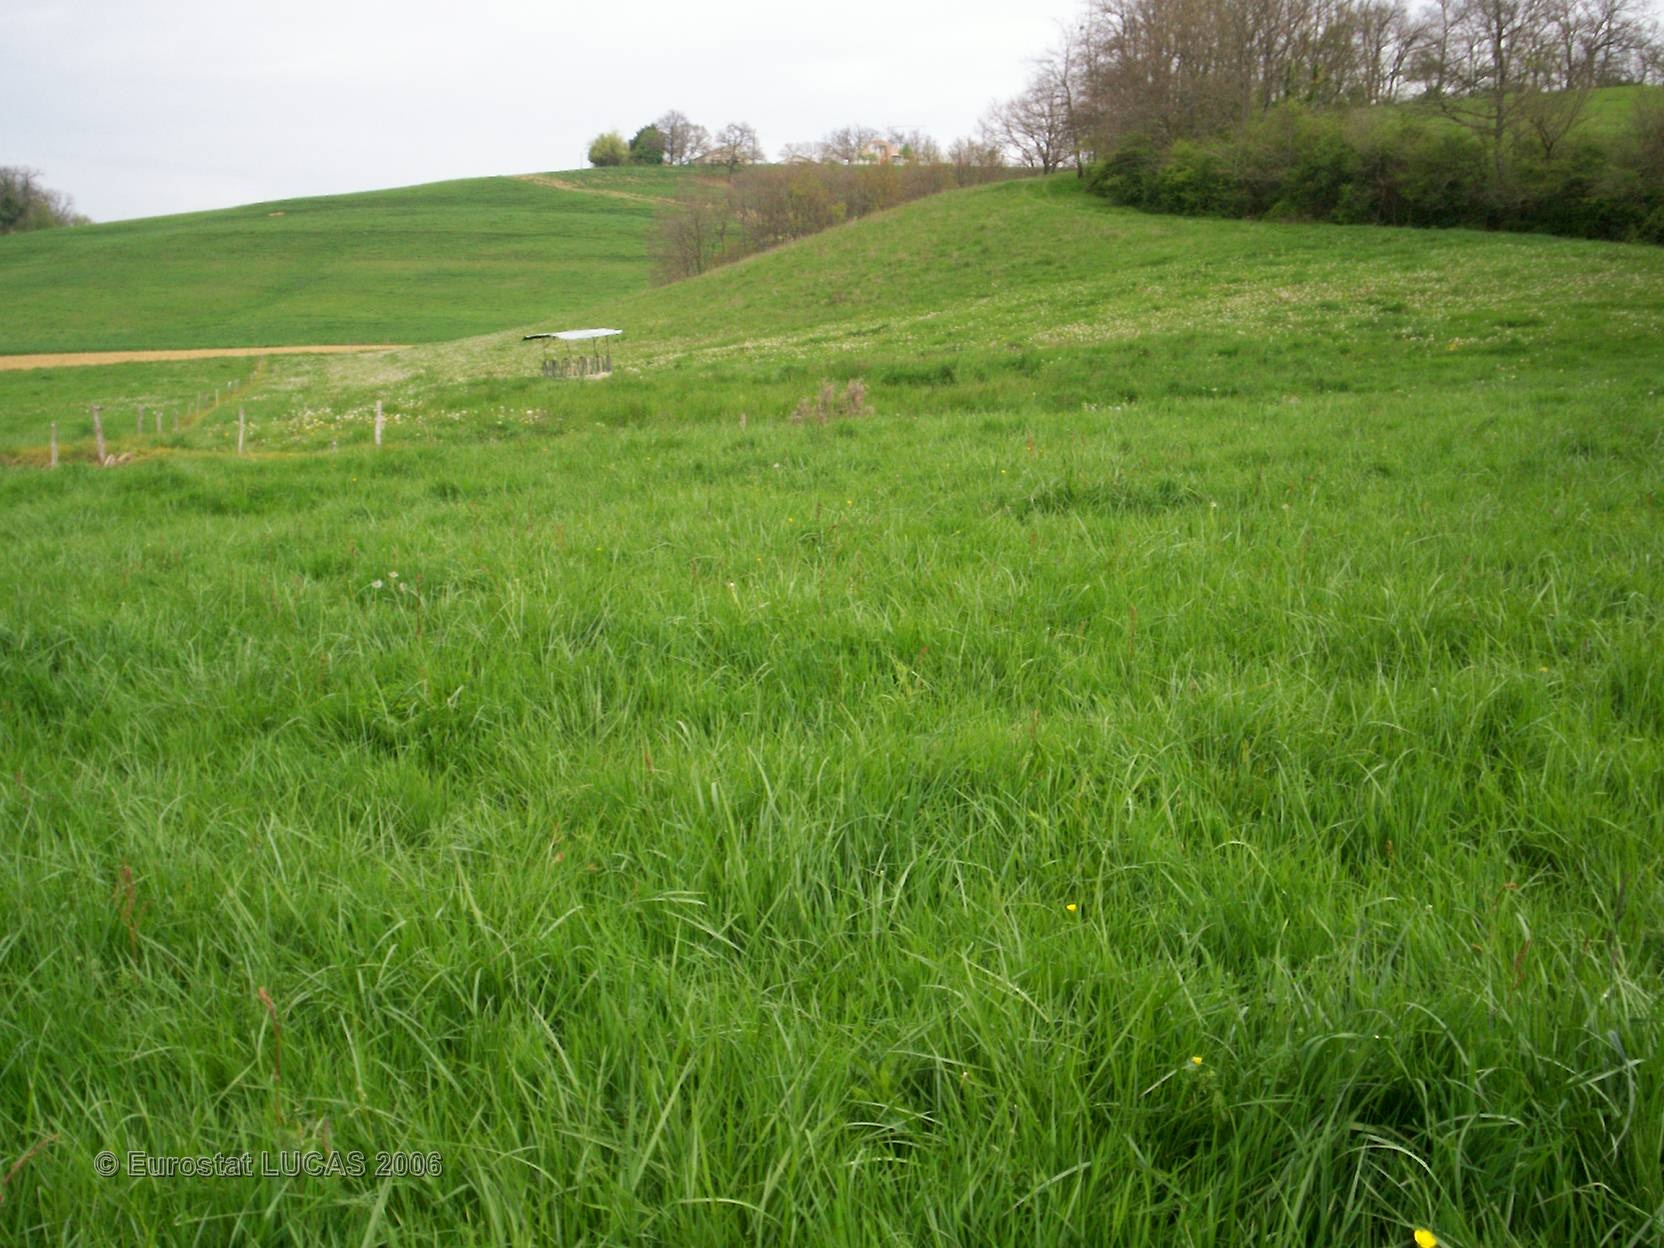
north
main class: Grassland
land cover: Grassland without tree/shrub cover
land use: Agriculture (excluding fallow land and kitchen gardens)
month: April
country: FR
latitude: 43.7223
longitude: 0.2007
